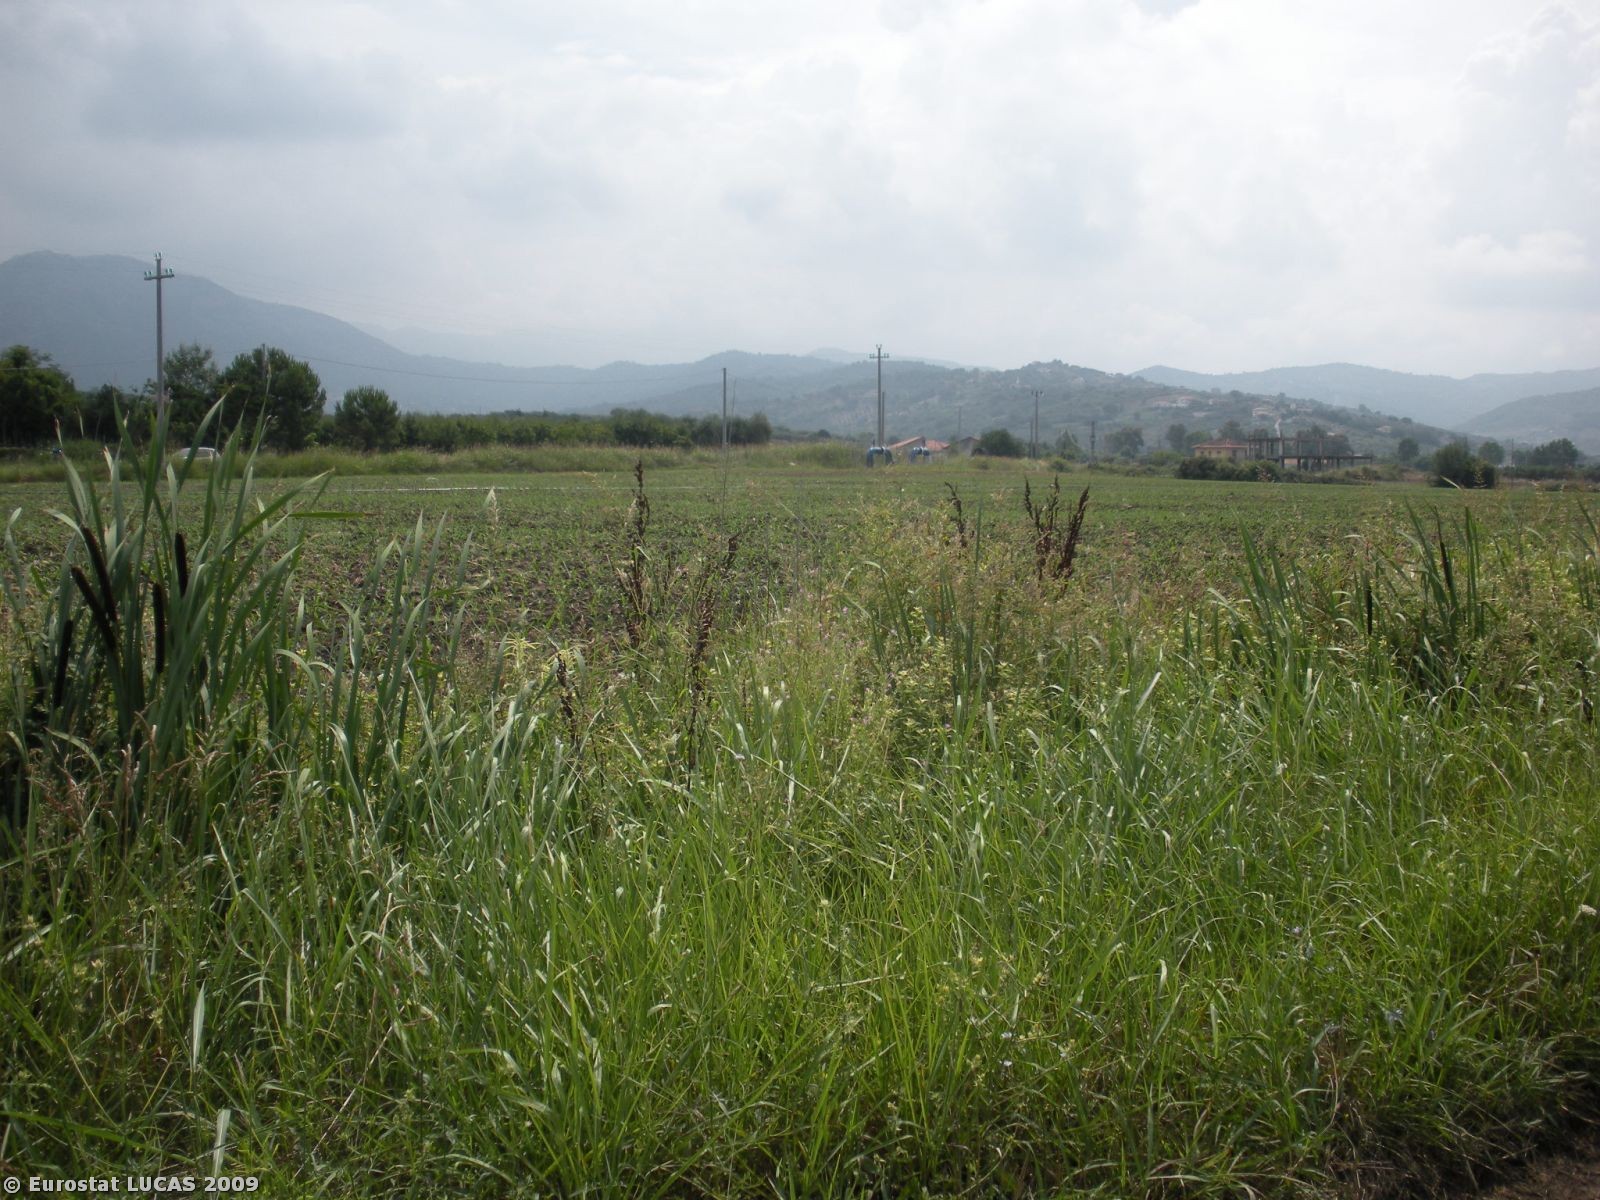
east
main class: Cropland
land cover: Maize
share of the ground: 10 - 25 %
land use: Agriculture (excluding fallow land and kitchen gardens)
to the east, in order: Maize; Bare land; Tracks; Grass margins; Ditches and canals; Grass margins; Maize; Artificial constructions; Electric lines; Grass margins; Paved roads, cycling and walking lanes; Grass margins; Tracks; Other fresh vegetables
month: July
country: IT
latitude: 40.3908
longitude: 15.0556
